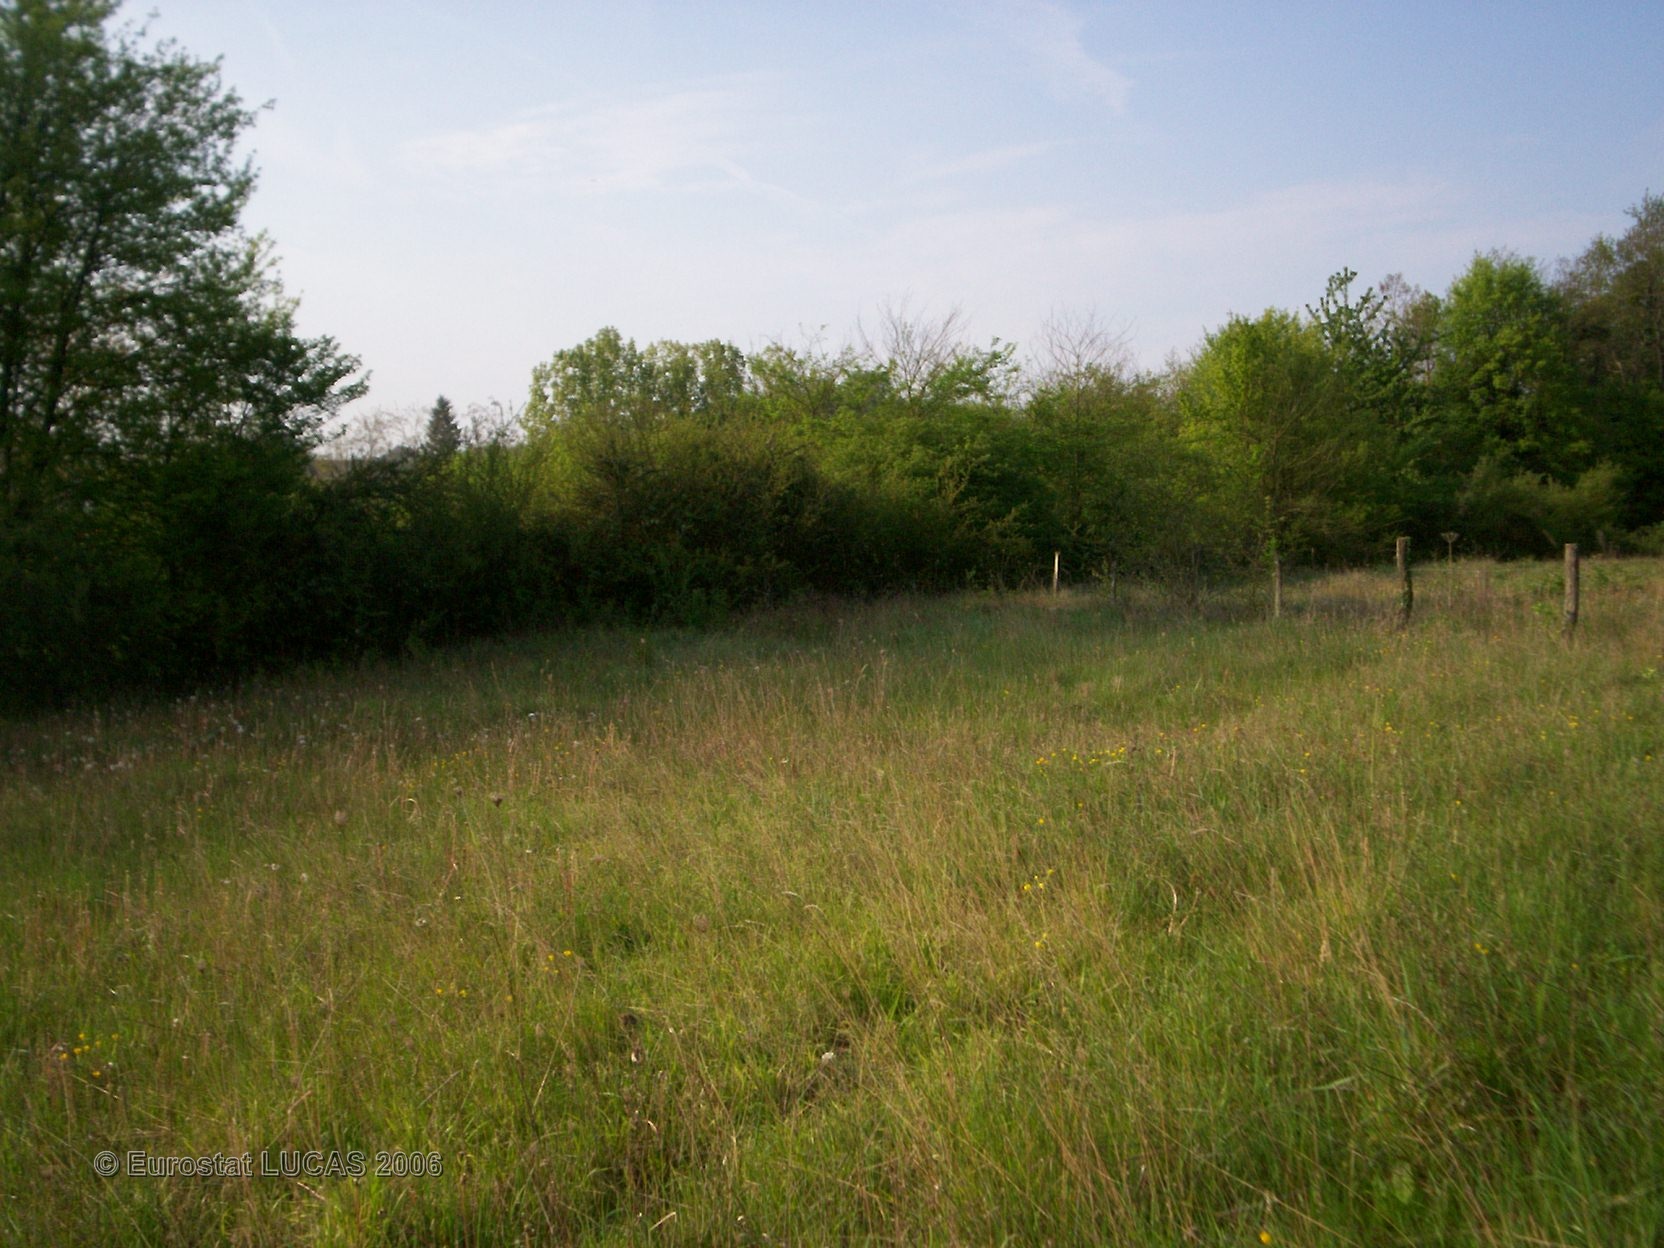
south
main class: Grassland
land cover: Grassland without tree/shrub cover
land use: Agriculture (excluding fallow land and kitchen gardens)
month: May
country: FR
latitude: 47.2621
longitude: 0.4238
